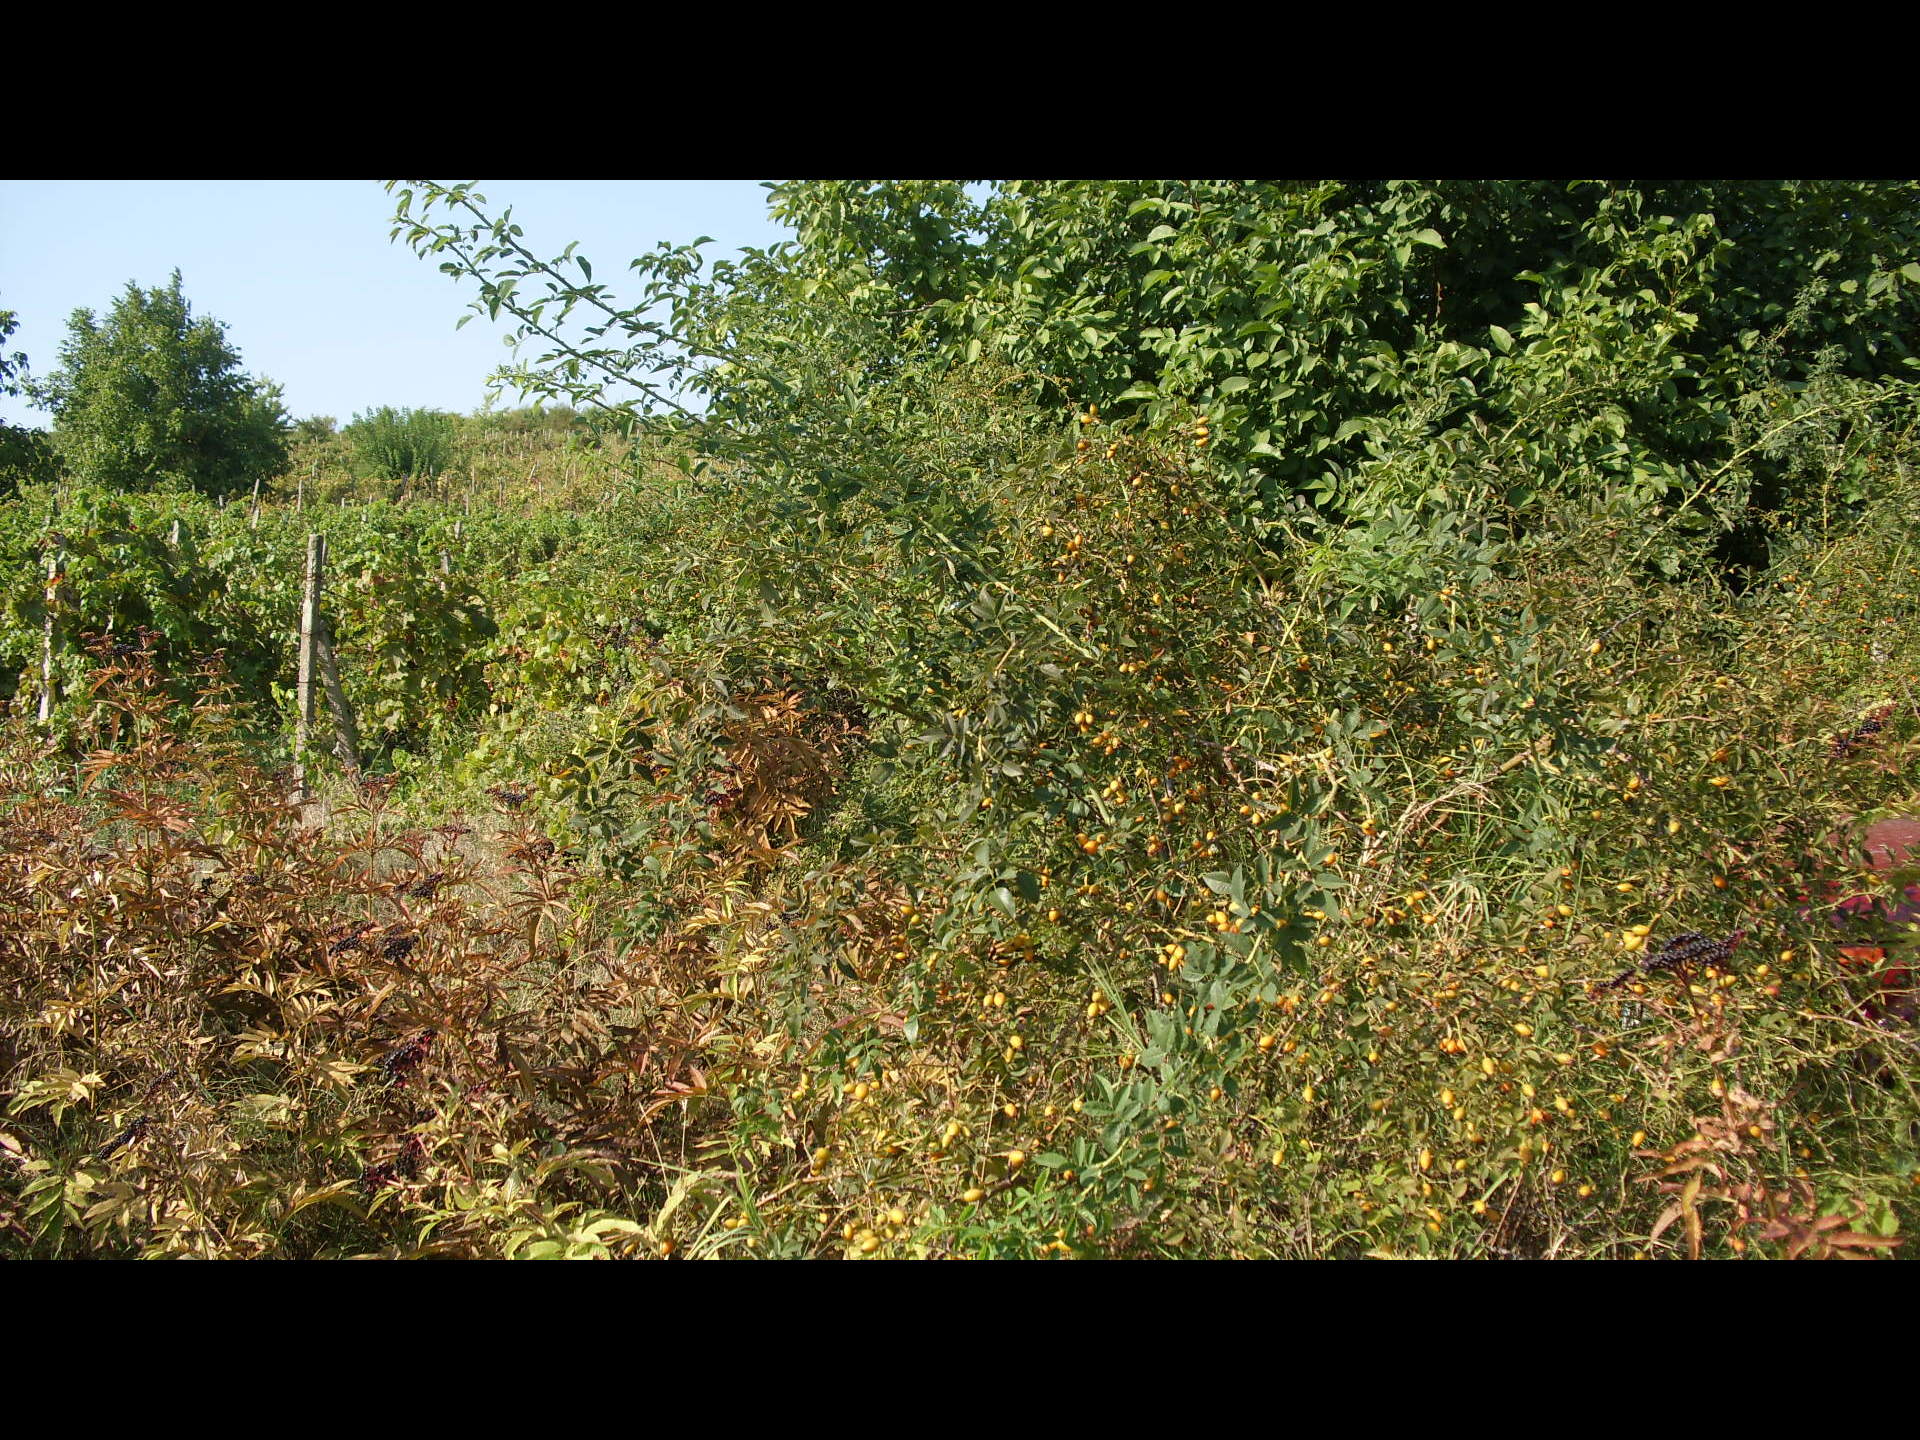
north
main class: Shrubland
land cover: Shrubland with sparse tree cover
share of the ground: > 75 %
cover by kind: herbaceous plants 85 %, shrubs 10 %, broadleaved forest trees 5 %
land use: Semi-natural and natural areas not in use
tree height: < 5 m
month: August
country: BG
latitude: 44.0490
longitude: 22.7820
